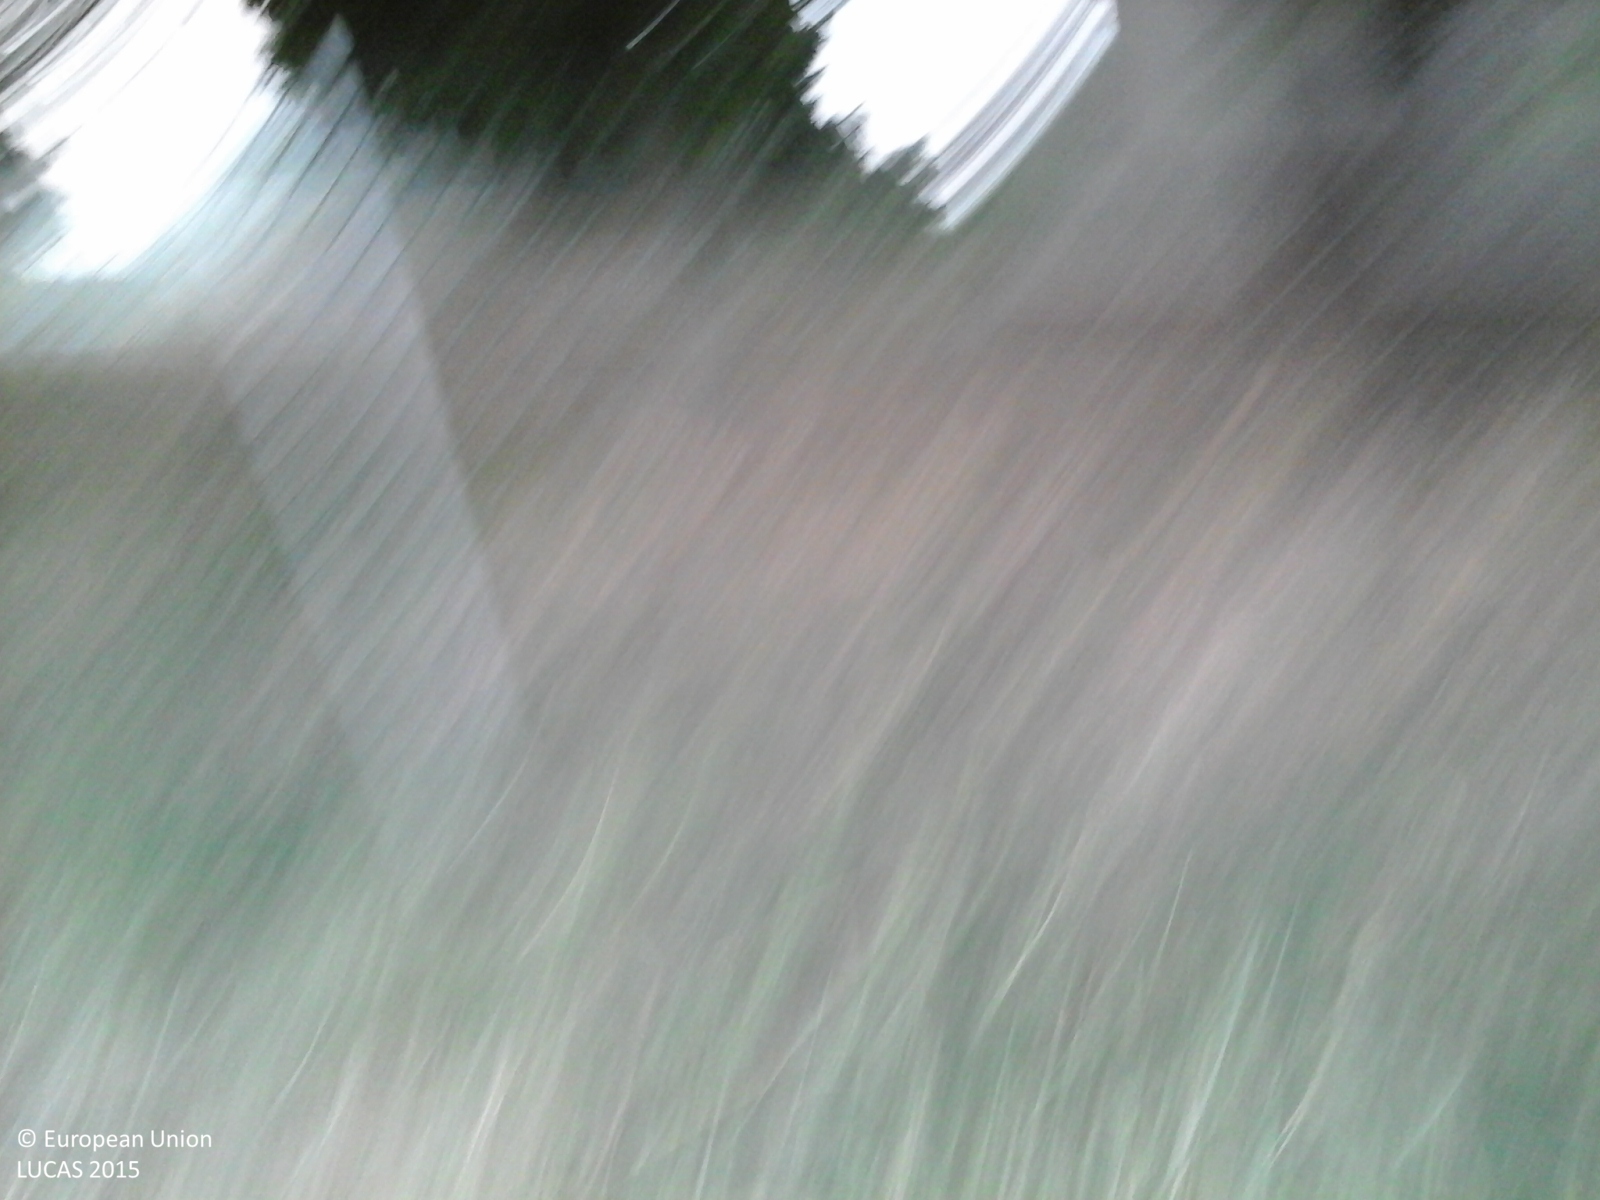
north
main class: Woodland
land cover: Broadleaved woodland
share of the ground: > 75 %
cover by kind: broadleaved forest trees 100 %
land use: Residential
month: July
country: IT
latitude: 44.3338
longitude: 11.8645
